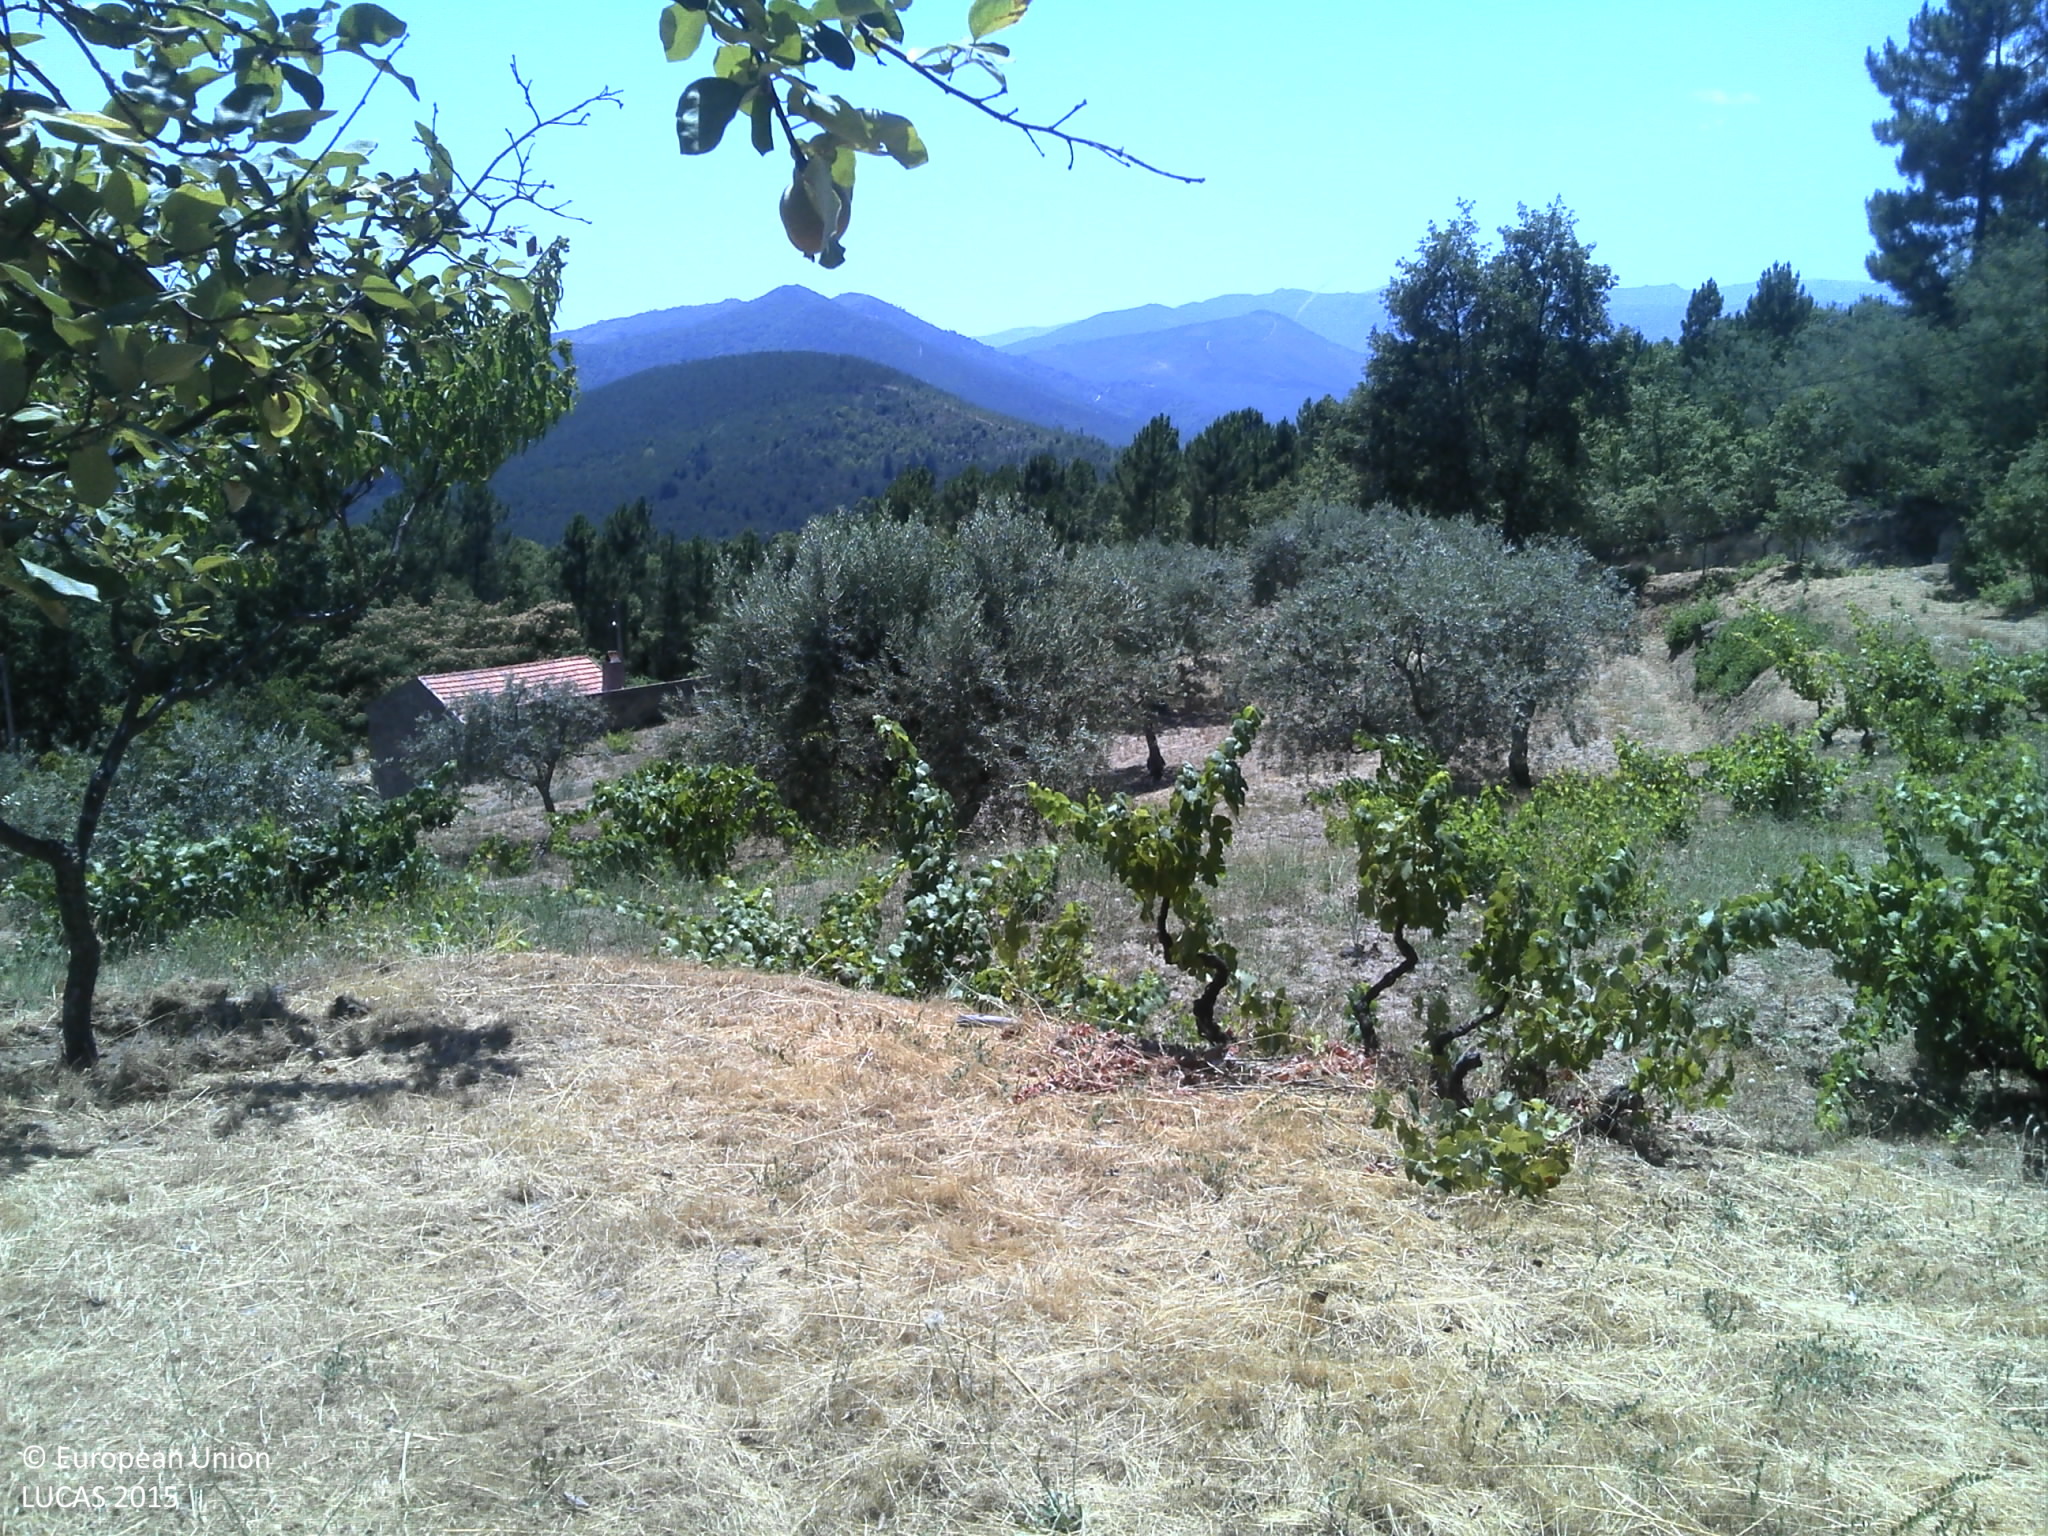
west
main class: Cropland
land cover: Pear fruit
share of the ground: 10 - 25 %
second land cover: Maize
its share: < 10 %
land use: Agriculture (excluding fallow land and kitchen gardens)
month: July
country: PT
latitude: 40.4200
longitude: -7.3726
